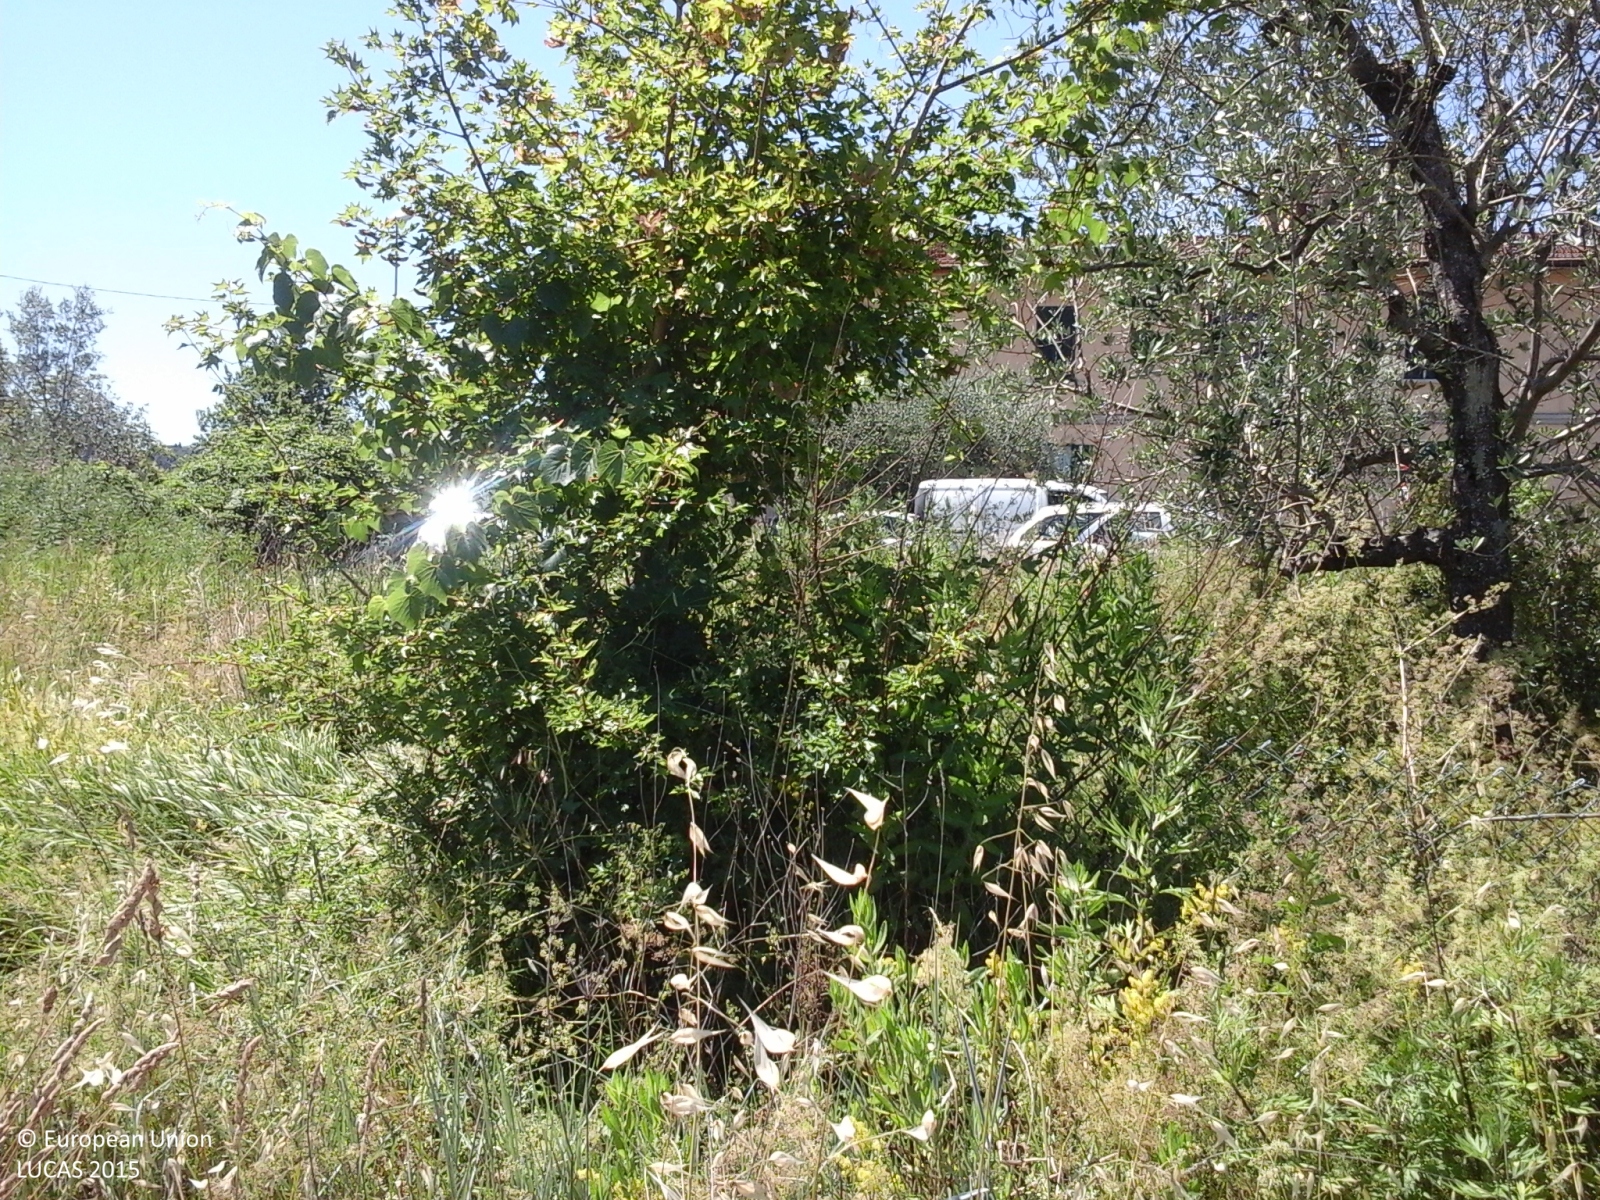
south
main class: Grassland
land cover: Grassland without tree/shrub cover
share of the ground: > 75 %
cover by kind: herbaceous plants 100 %
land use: Agriculture (excluding fallow land and kitchen gardens)
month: June
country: IT
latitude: 43.7857
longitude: 11.0783
